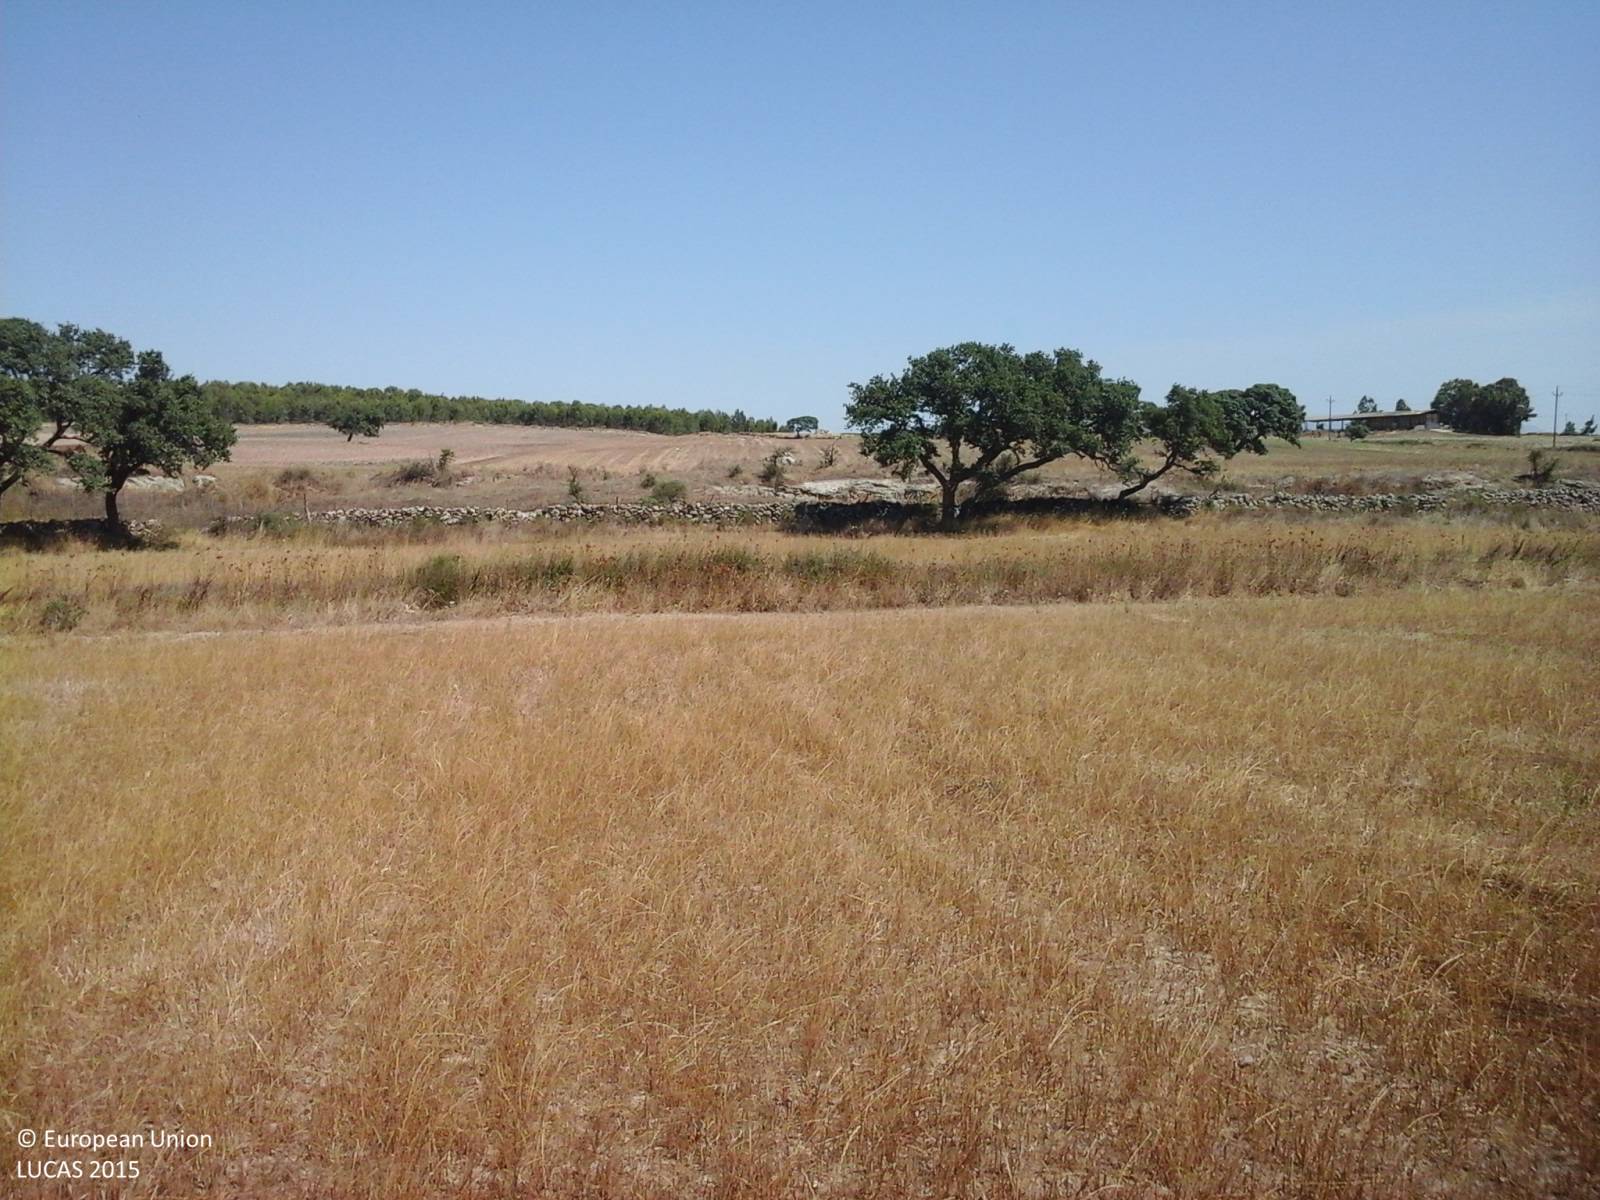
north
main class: Cropland
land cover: Oats
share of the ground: < 10 %
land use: Agriculture (excluding fallow land and kitchen gardens)
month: July
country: IT
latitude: 40.5871
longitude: 8.9066
